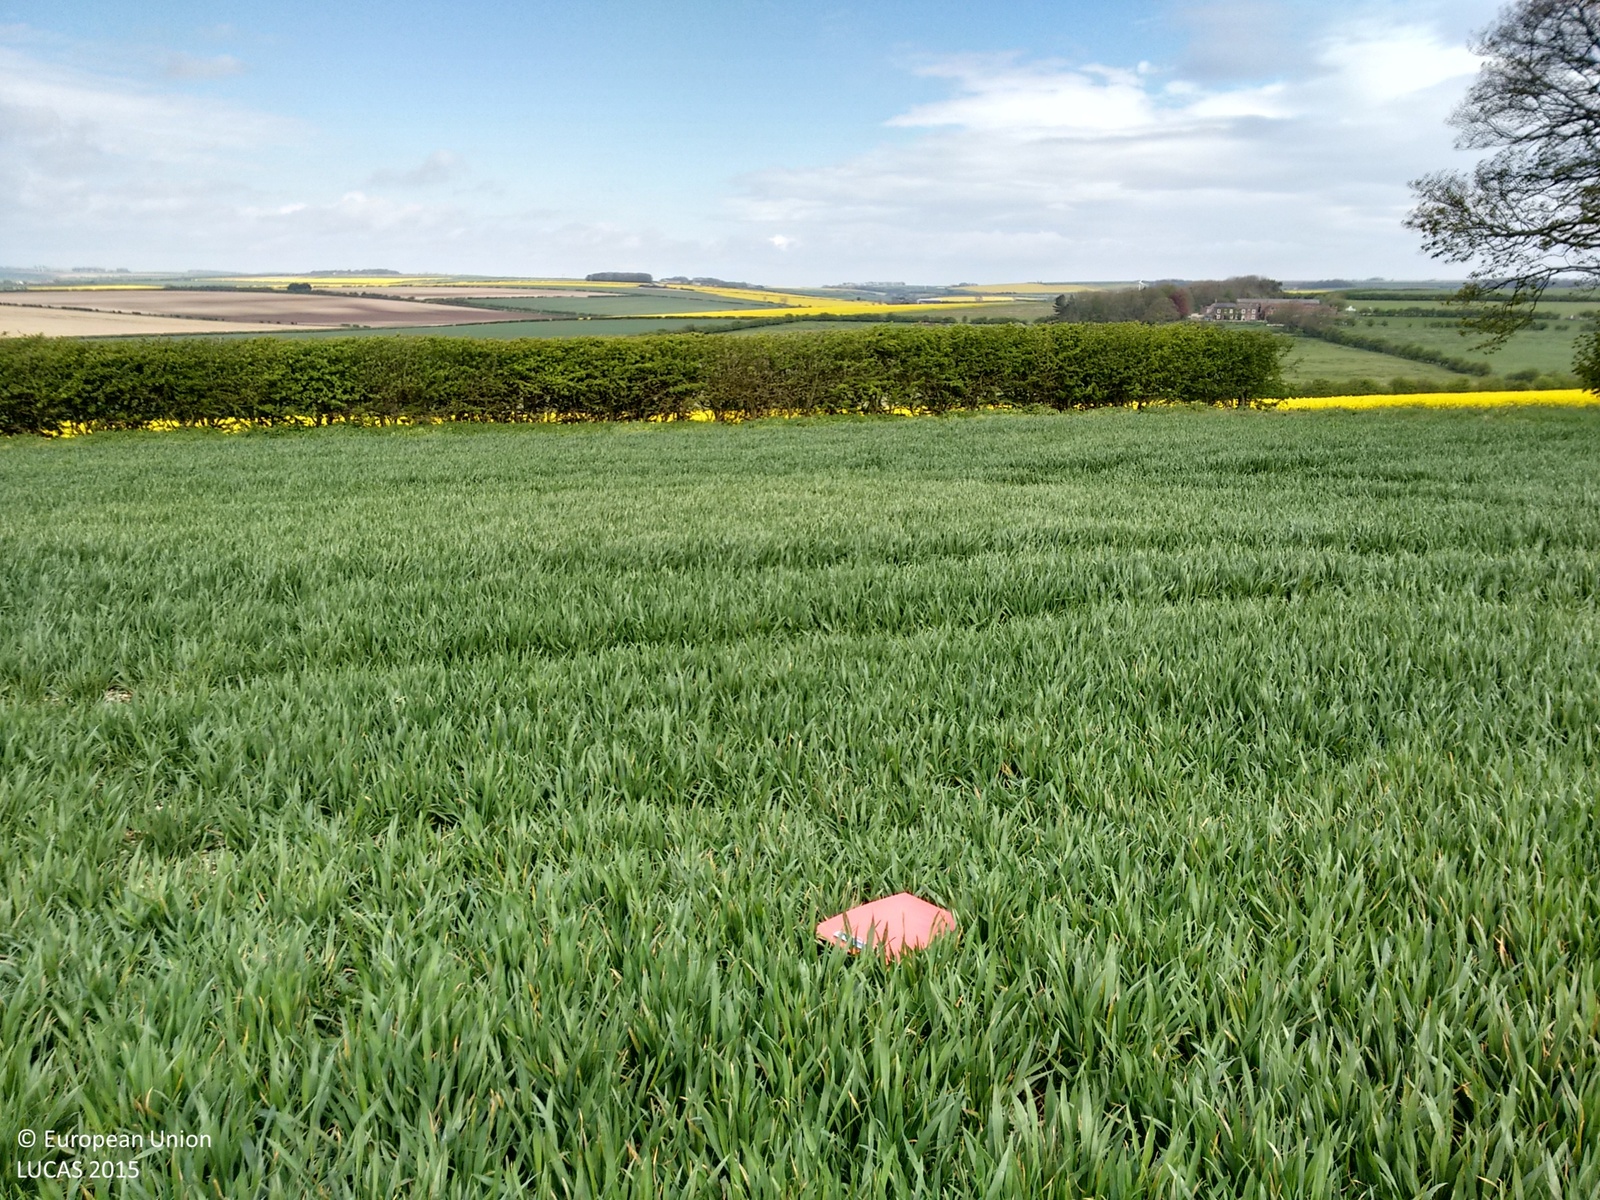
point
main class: Cropland
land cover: Common wheat
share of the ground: > 75 %
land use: Agriculture (excluding fallow land and kitchen gardens)
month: May
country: GB
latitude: 54.1219
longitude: -0.3006
